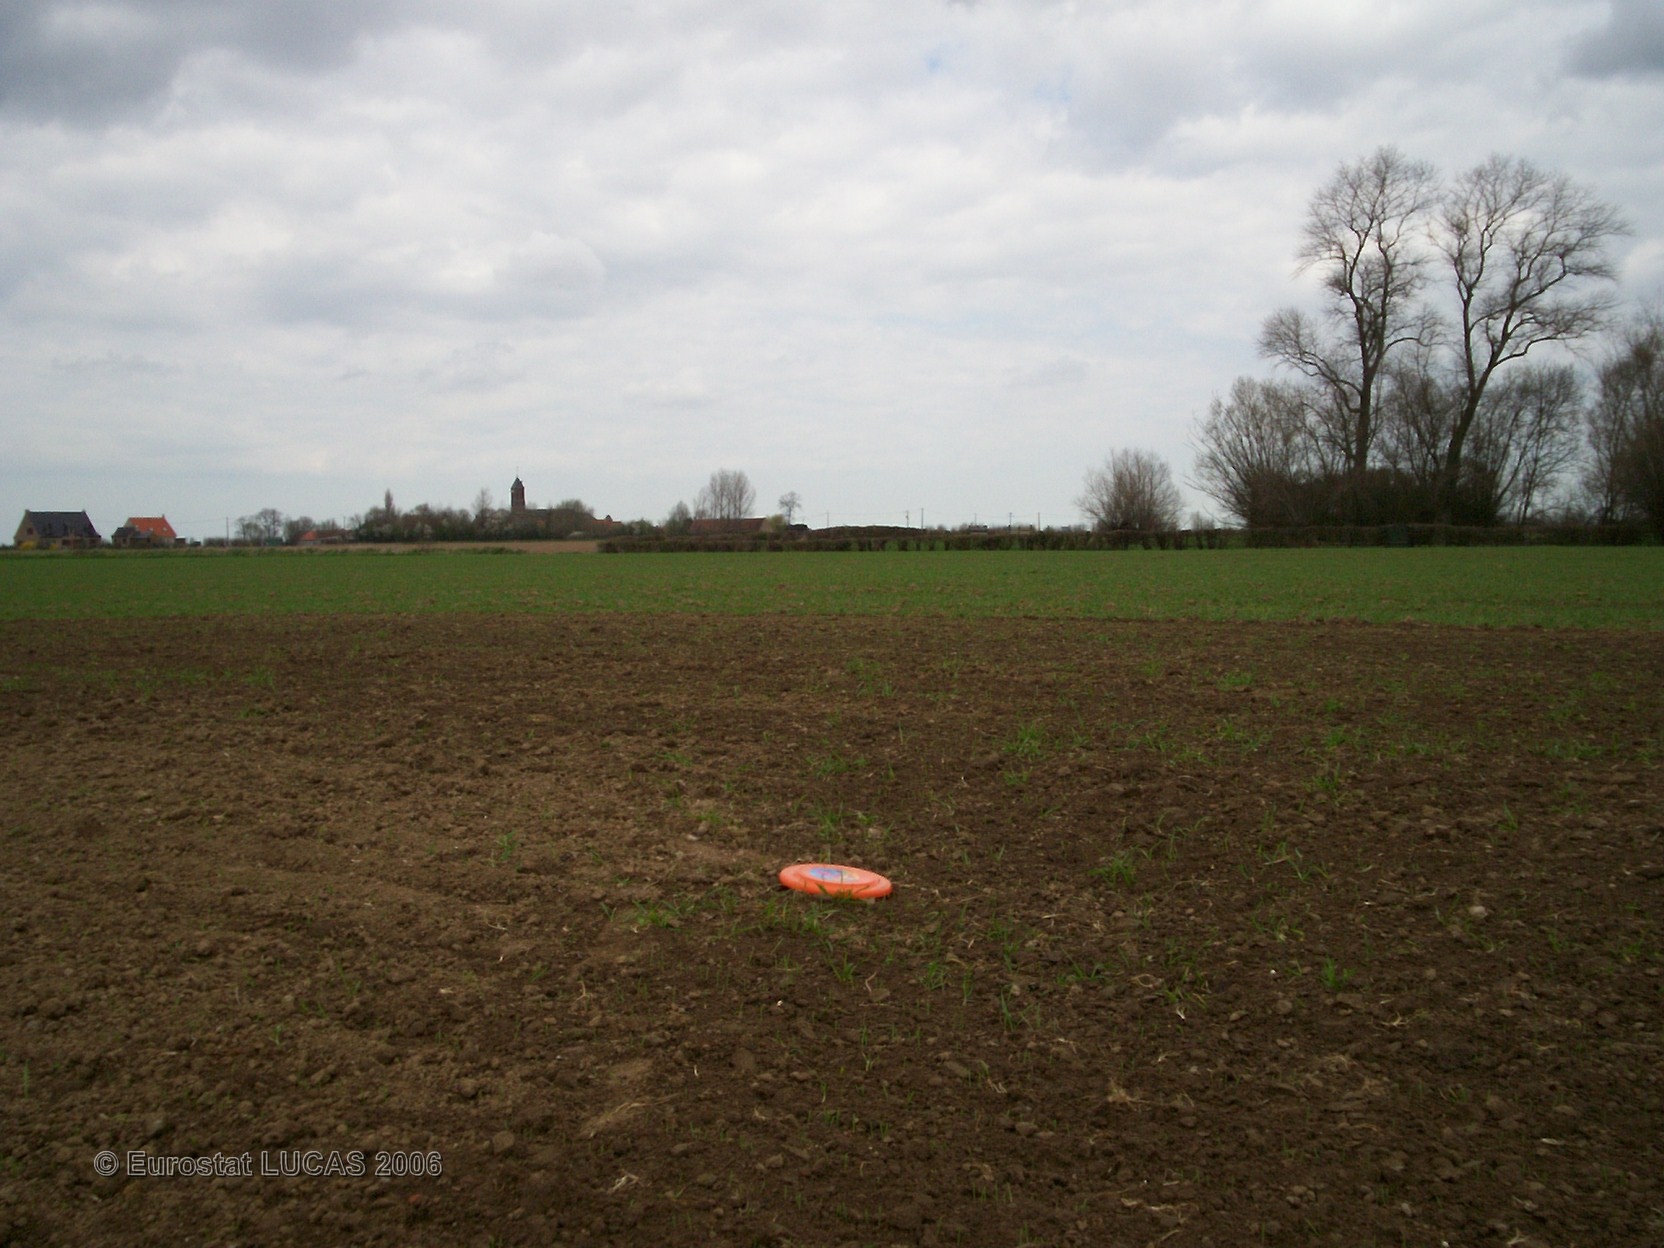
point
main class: Cropland
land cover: Common wheat
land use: Agriculture (excluding fallow land and kitchen gardens)
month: April
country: FR
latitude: 50.9062
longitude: 2.4069
